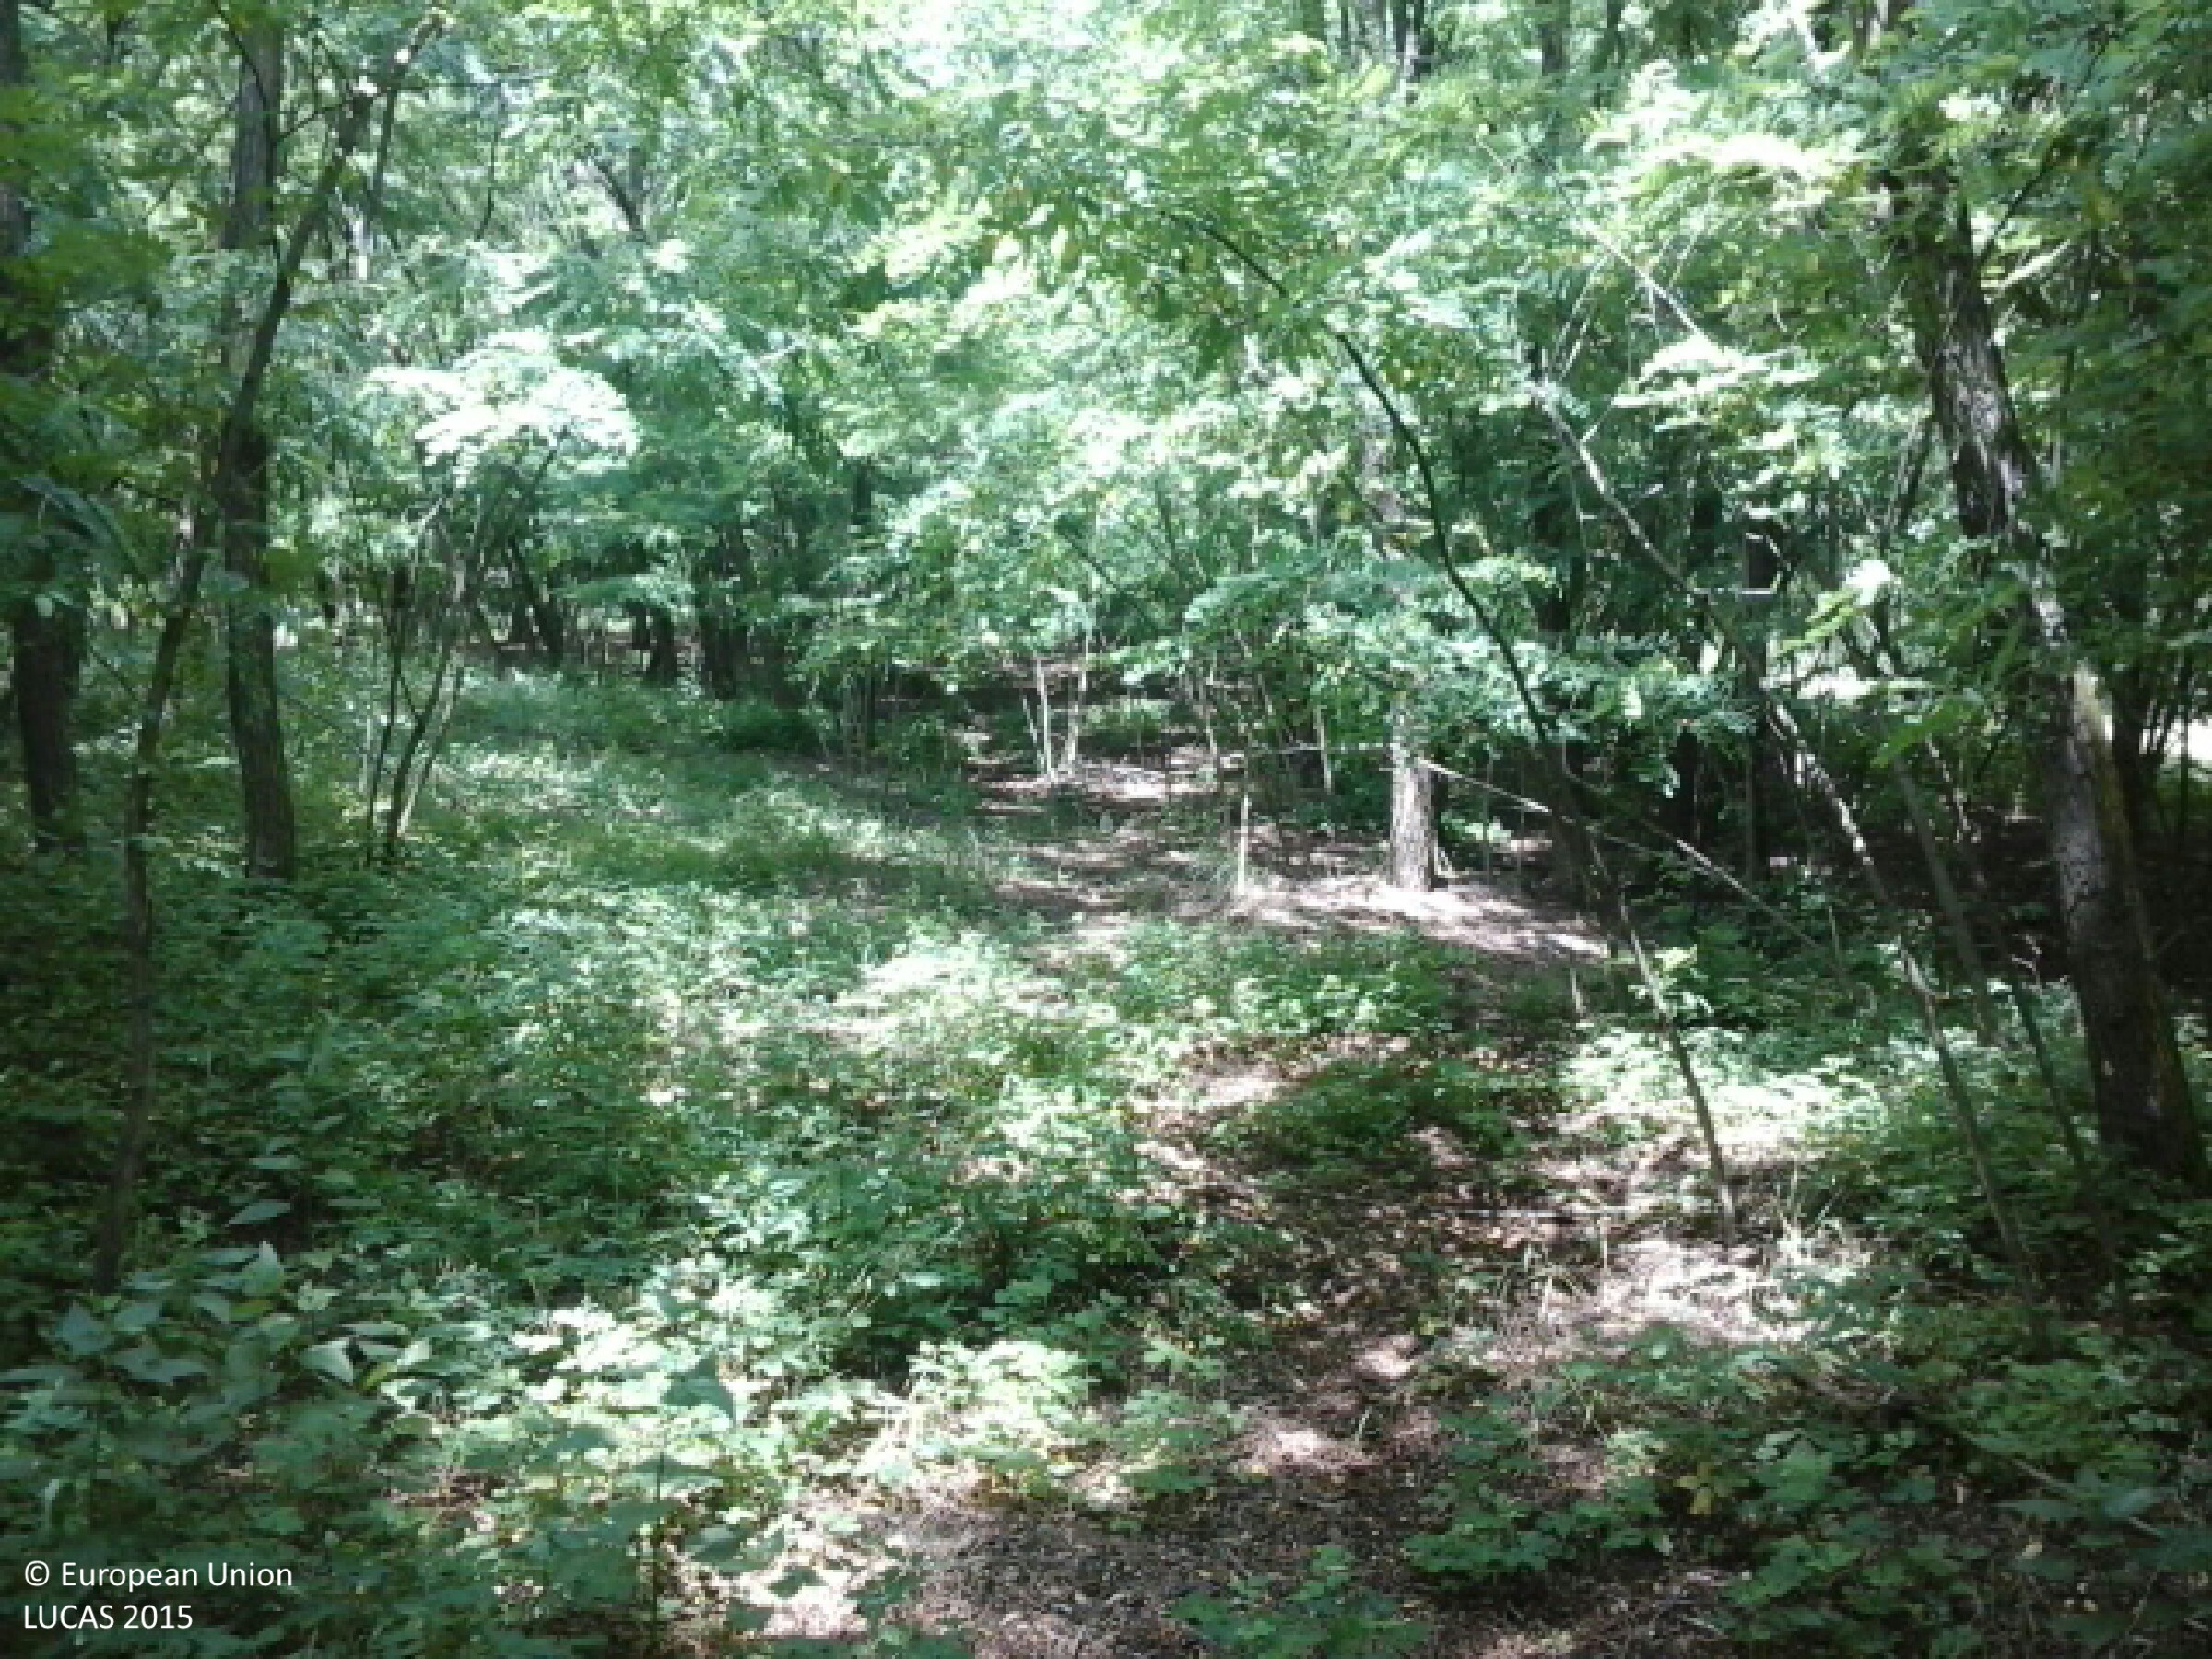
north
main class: Woodland
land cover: Broadleaved woodland
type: mesophytic deciduous forest
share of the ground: > 75 %
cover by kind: broadleaved forest trees 95 %, herbaceous plants 5 %
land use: Forestry
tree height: > 5 m
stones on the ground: < 10 %
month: June
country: HU
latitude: 48.1119
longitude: 22.1567
